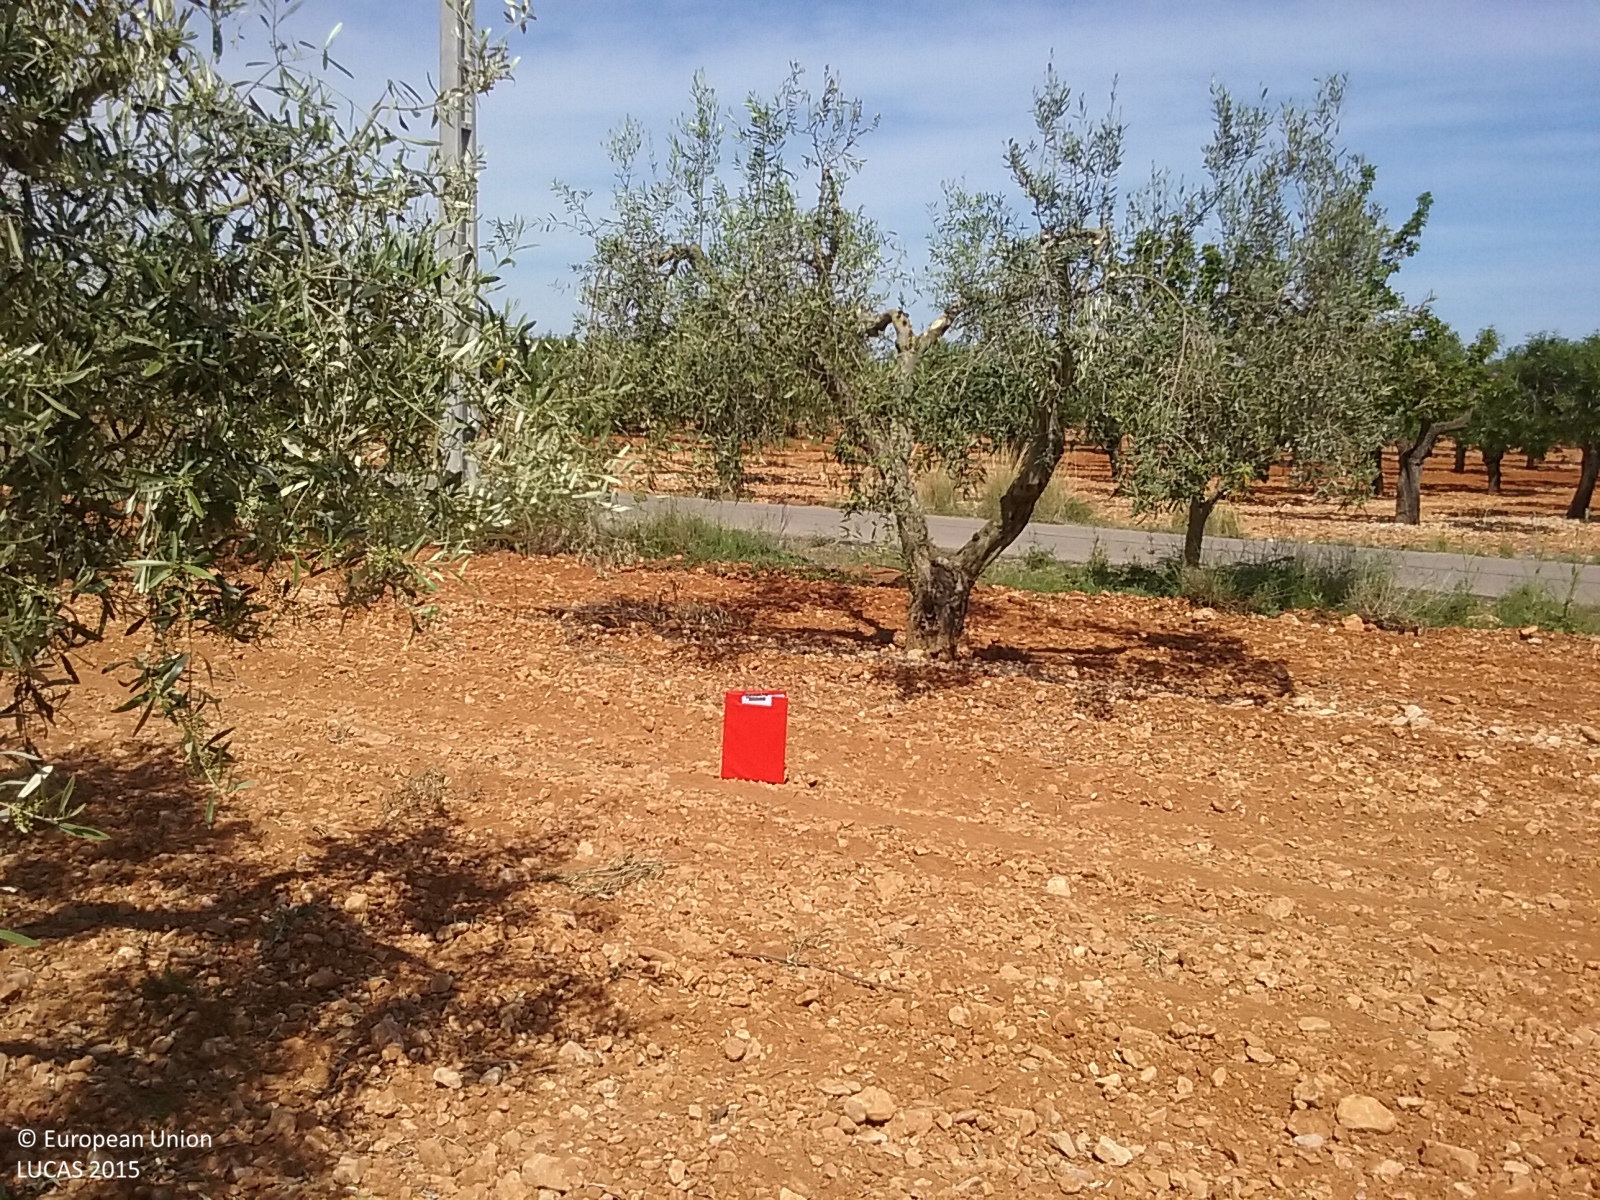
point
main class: Cropland
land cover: Olive groves
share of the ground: 25 - 50 %
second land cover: Other bare soil
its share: > 75 %
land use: Agriculture (excluding fallow land and kitchen gardens)
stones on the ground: 25 - 50 %
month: May
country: ES
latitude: 40.1746
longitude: 0.0039
